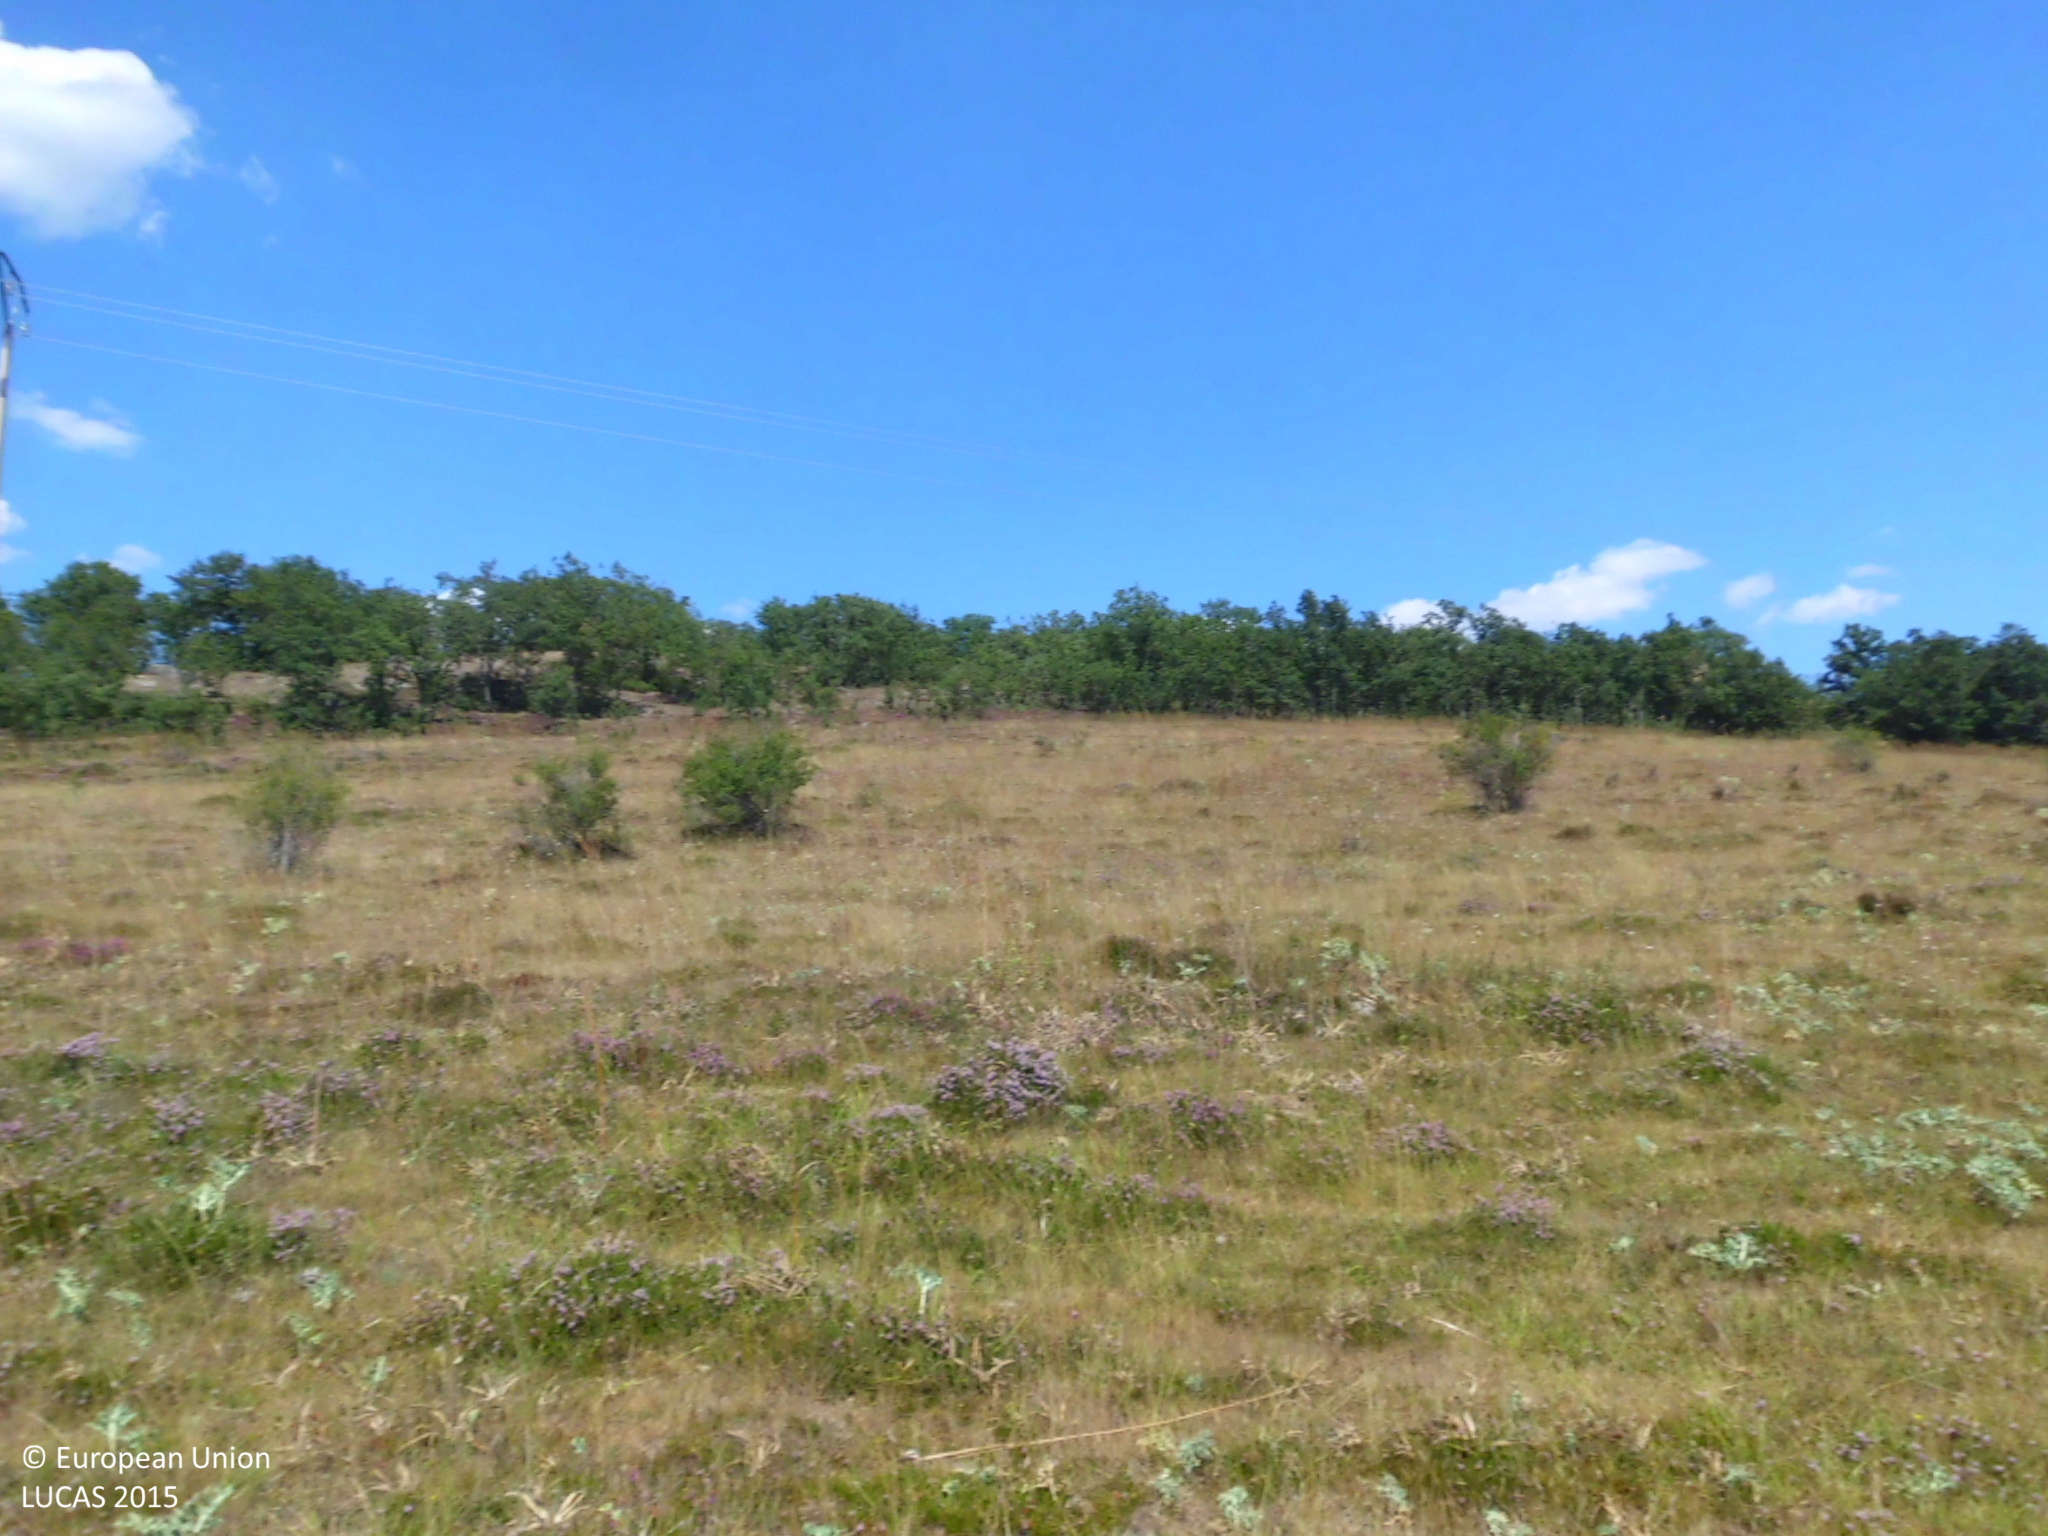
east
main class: Grassland
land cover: Grassland without tree/shrub cover
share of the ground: > 75 %
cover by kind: herbaceous plants 95 %, shrubs 5 %
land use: Agriculture (excluding fallow land and kitchen gardens)
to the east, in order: Grassland without tree/shrub cover; Electric lines; Grassland without tree/shrub cover; Broadleaved woodland; Shrubland without tree cover
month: July
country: ES
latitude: 42.8342
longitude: -4.3535
